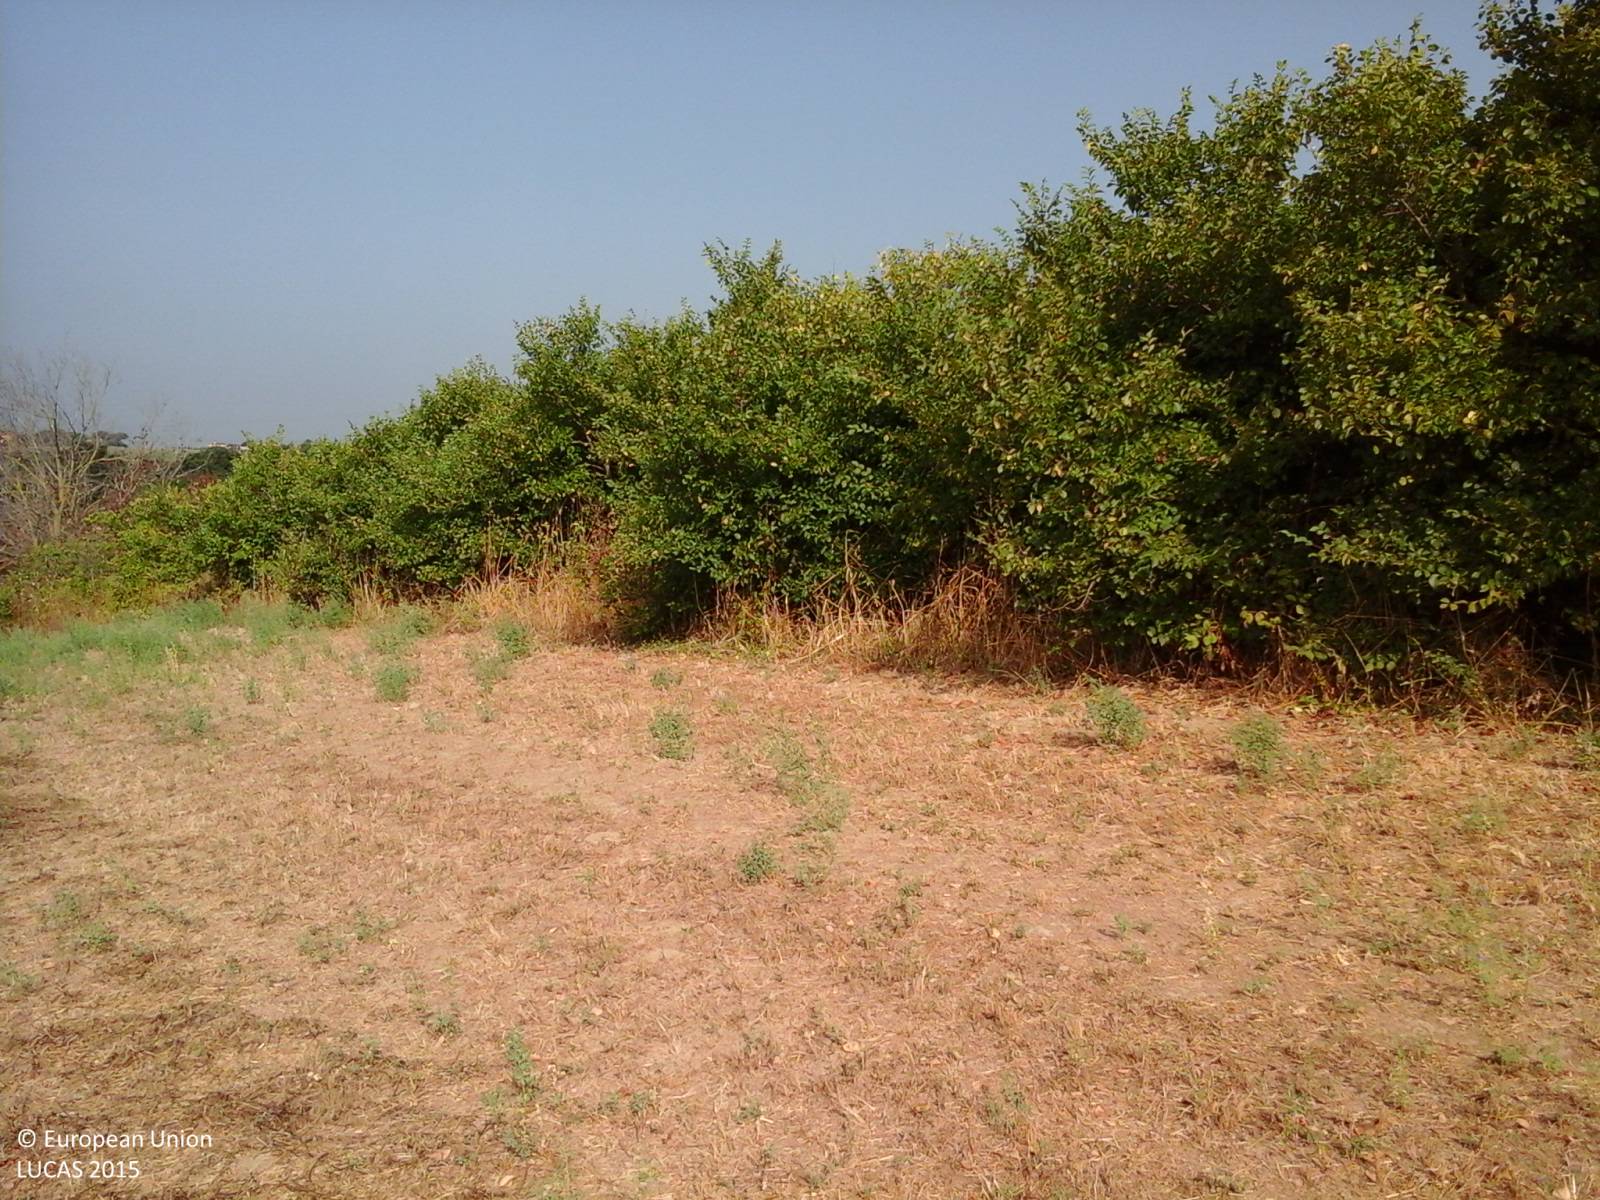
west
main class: Cropland
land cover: Lucerne
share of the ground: > 75 %
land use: Agriculture (excluding fallow land and kitchen gardens)
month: July
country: IT
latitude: 41.9604
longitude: 12.2478
